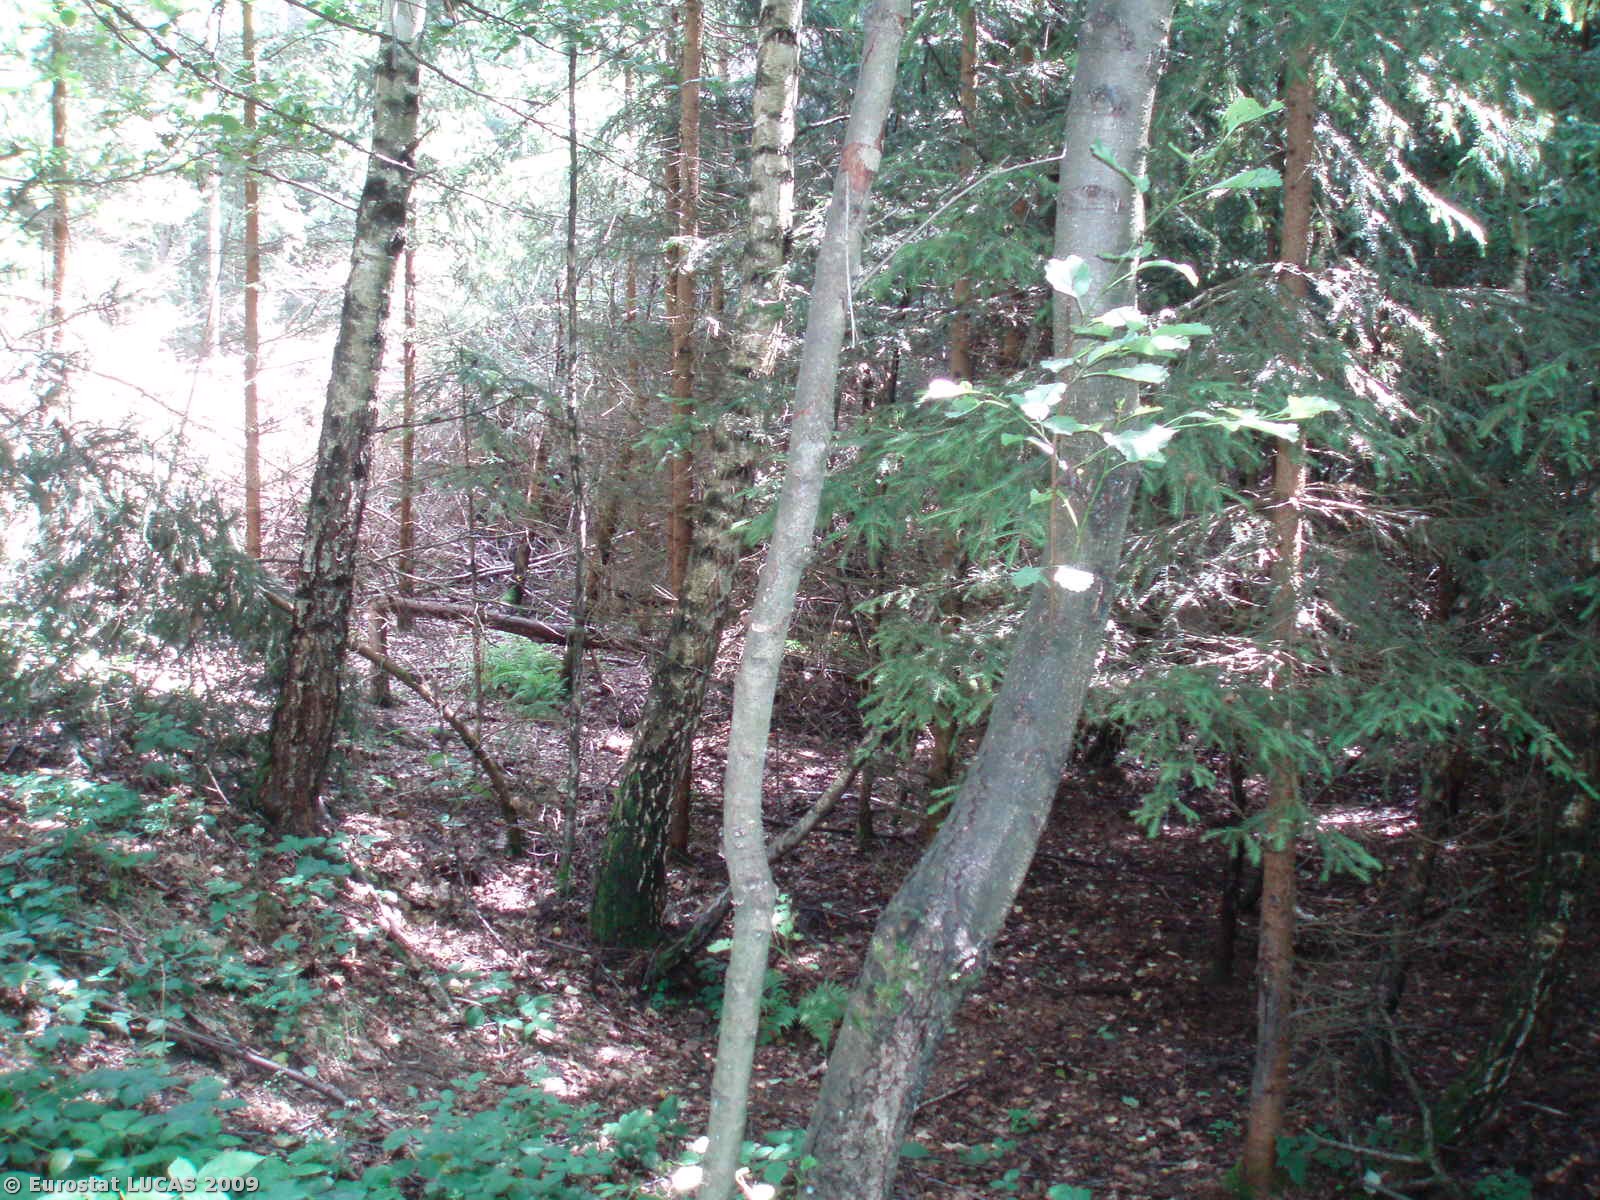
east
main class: Woodland
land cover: Mixed woodland
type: hemiboreal forest and nemoral coniferous forest and mixed broadleaved-coniferous forest
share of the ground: > 75 %
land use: Forestry
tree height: > 5 m
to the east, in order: Mixed woodland; Coniferous woodland; Mixed woodland; Broadleaved woodland; Oats
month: July
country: CZ
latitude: 50.6358
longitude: 14.9372
